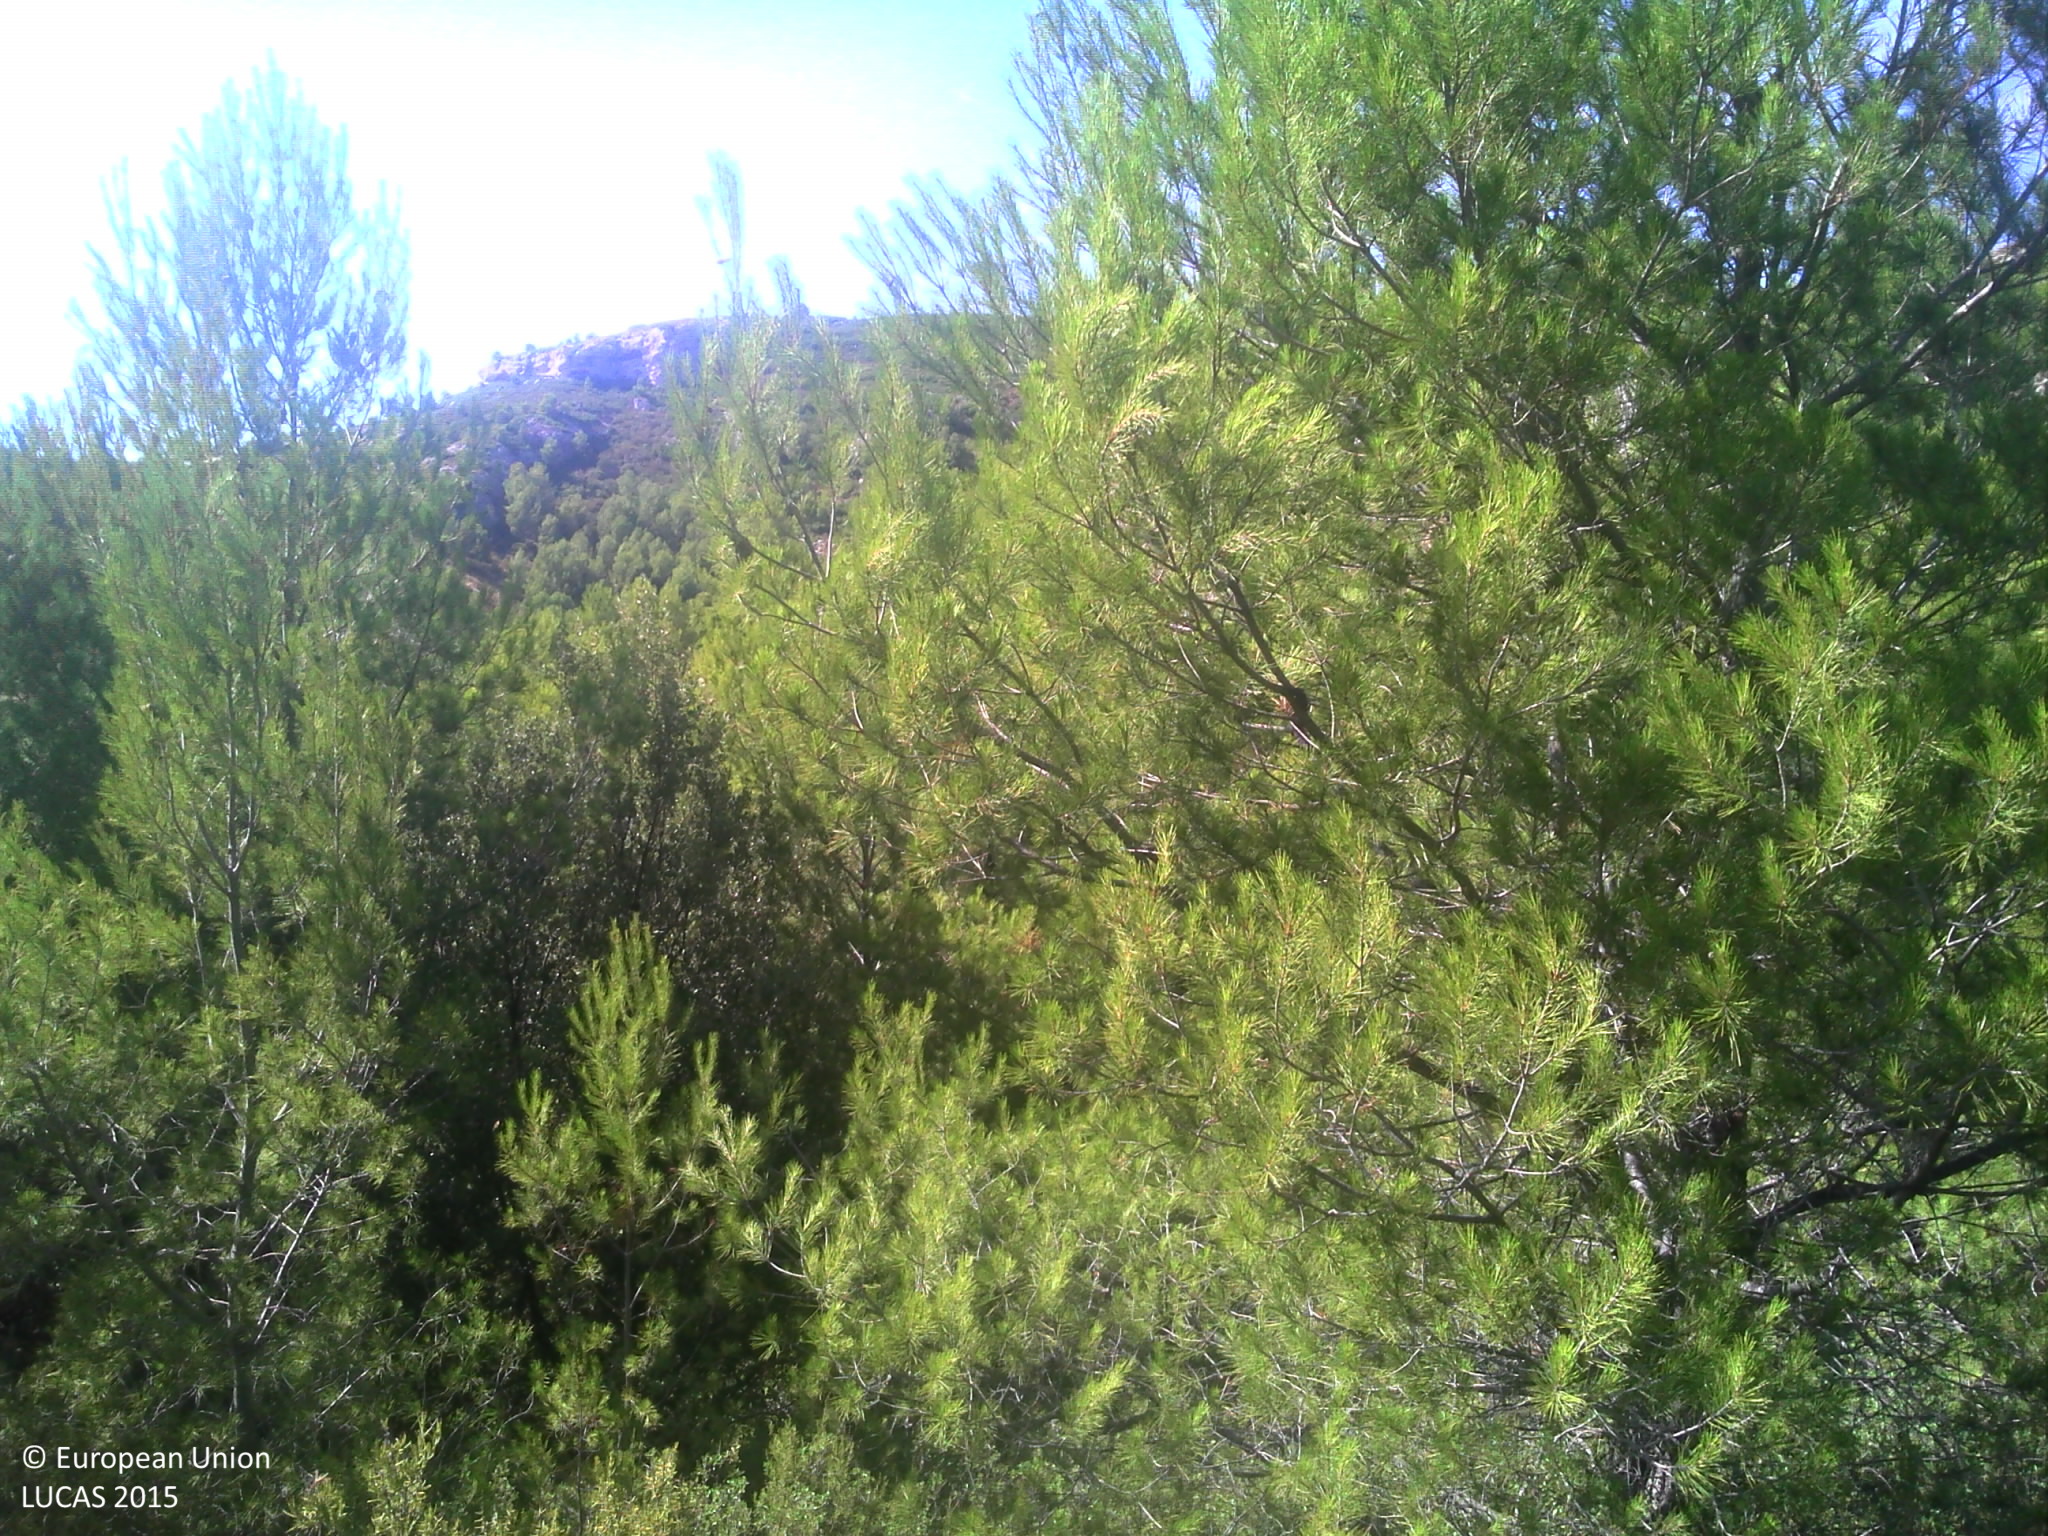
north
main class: Woodland
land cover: Pine dominated coniferous woodland
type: coniferous forest of the mediterranean region
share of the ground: 25 - 50 %
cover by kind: shrubs 55 %, coniferous forest trees 45 %
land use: Forestry
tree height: < 5 m
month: August
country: FR
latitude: 43.3804
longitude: 5.3815
